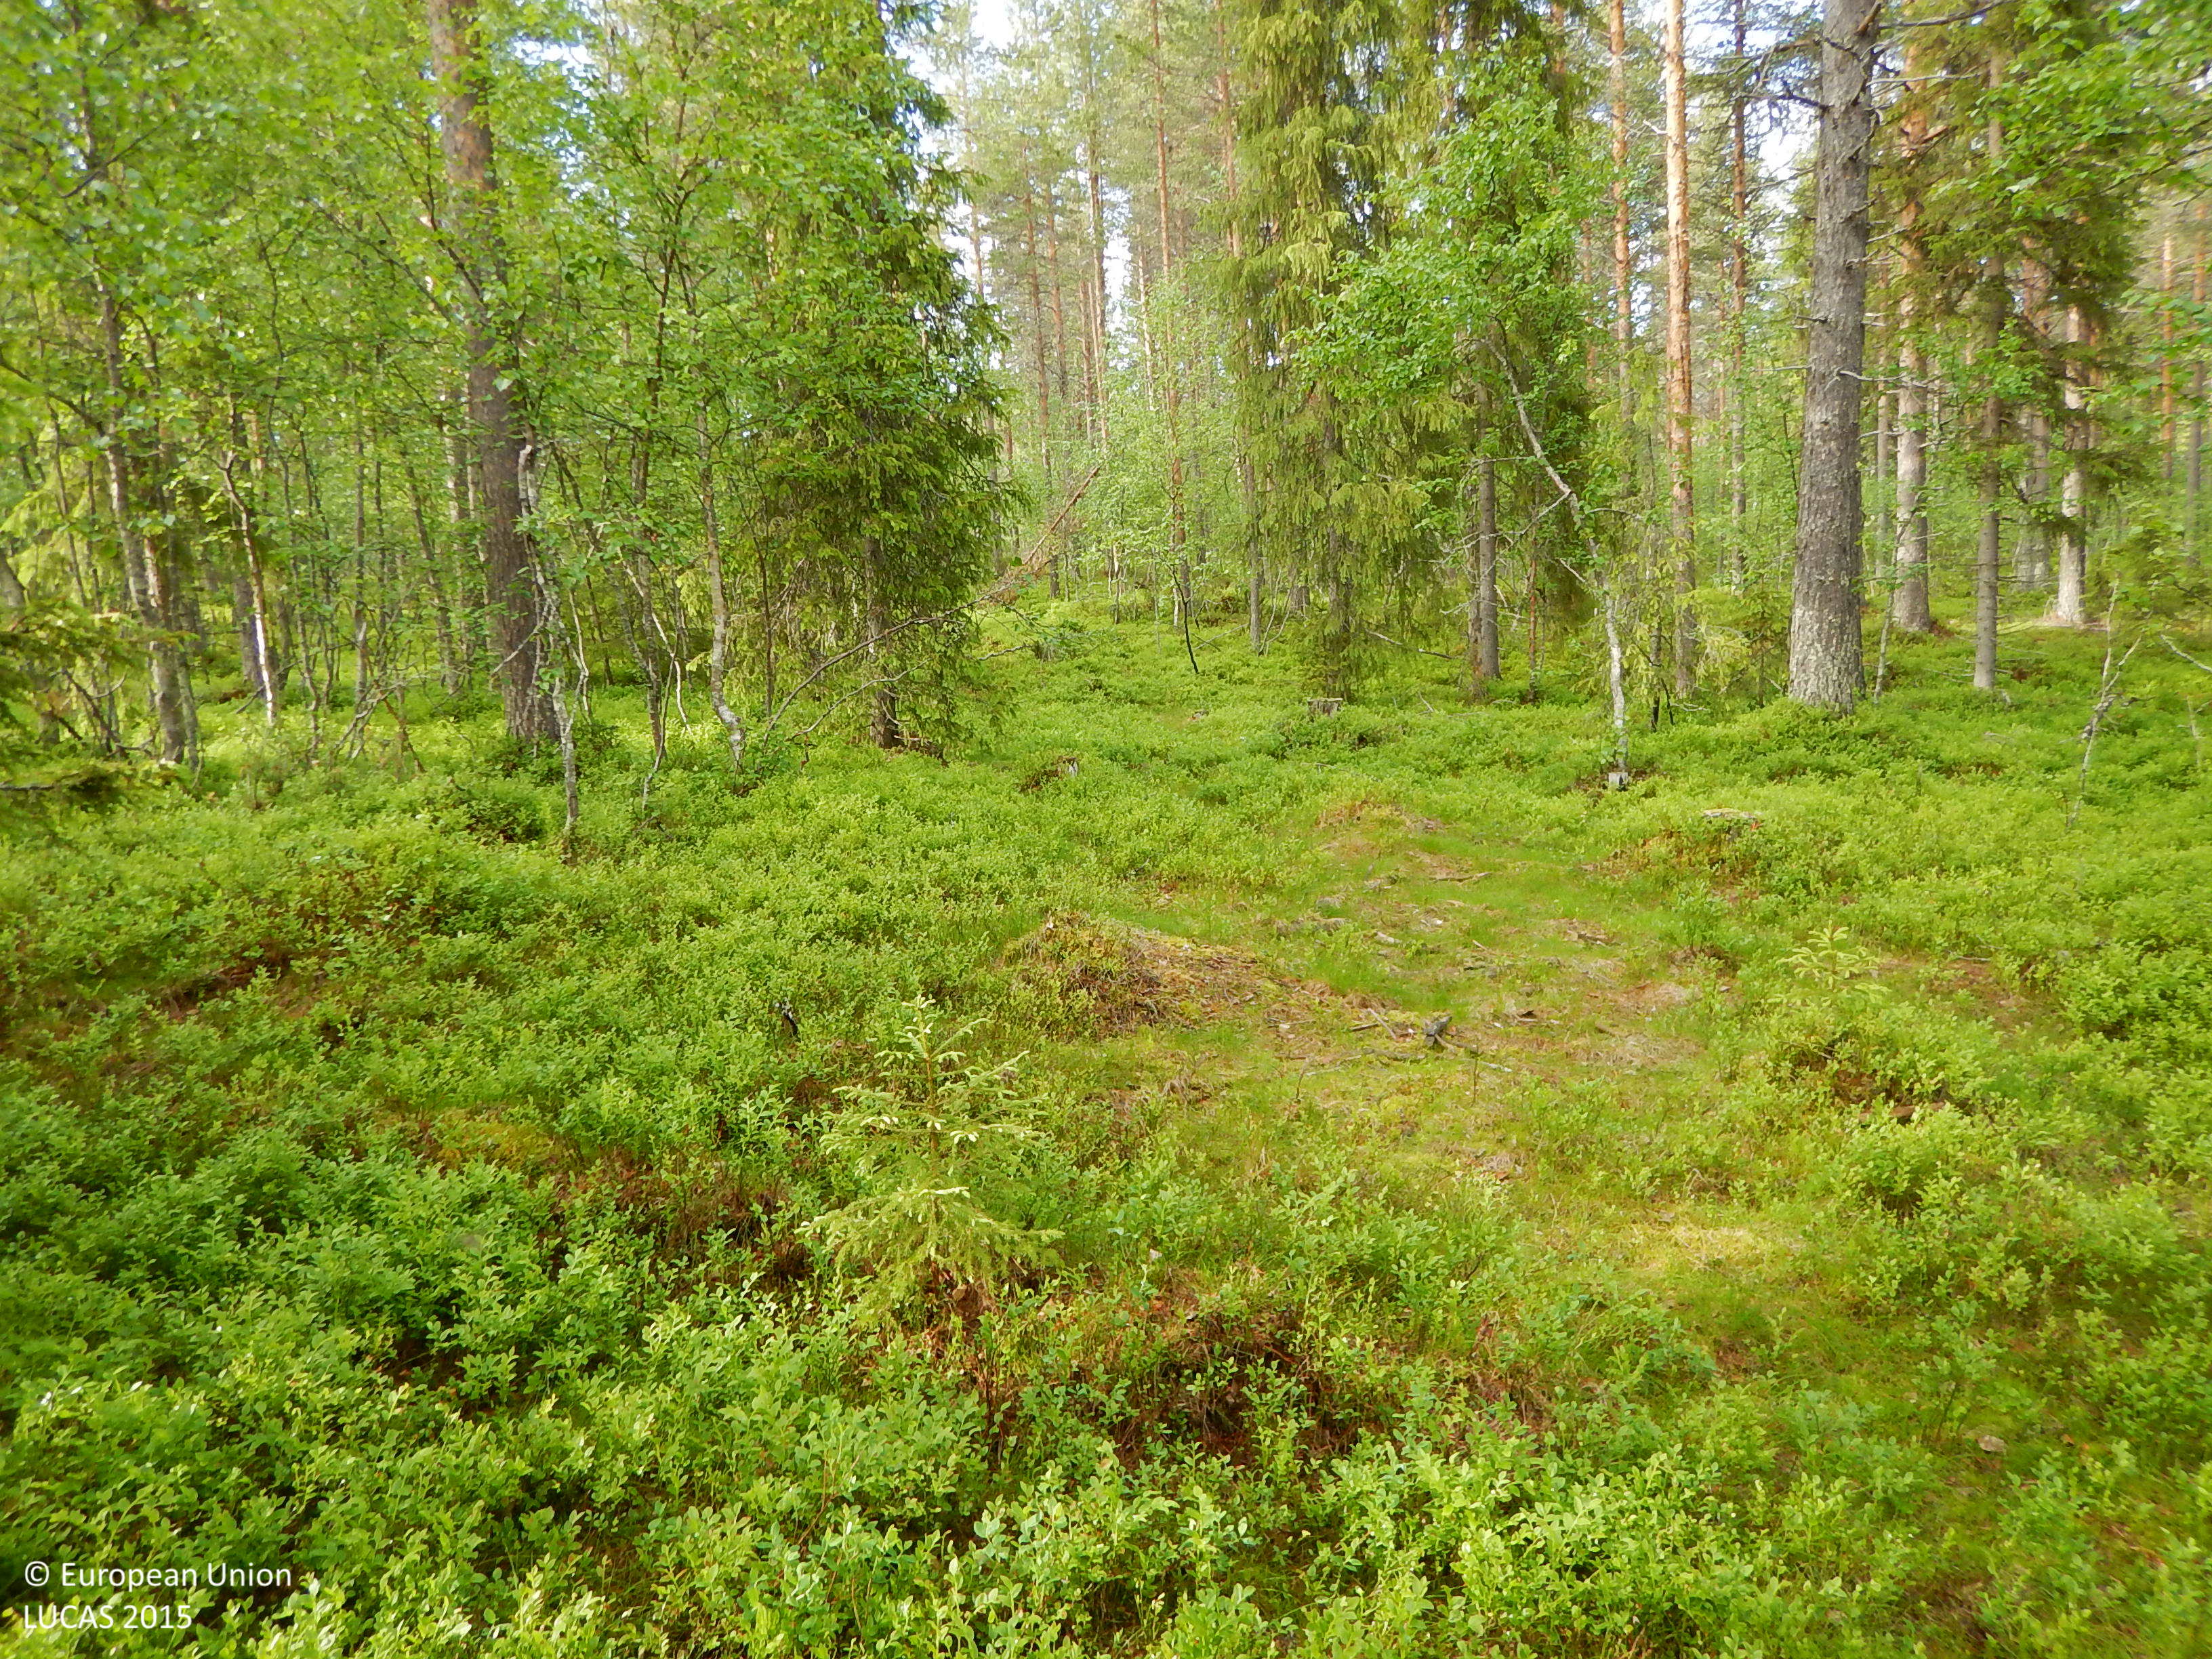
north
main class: Woodland
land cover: Other mixed woodland
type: boreal forest
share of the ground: 50 - 75 %
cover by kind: coniferous forest trees 45 %, shrubs 20 %, broadleaved forest trees 15 %, herbaceous plants 15 %, lichens and mosses 5 %
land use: Forestry
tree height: > 5 m
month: July
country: SE
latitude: 65.2935
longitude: 19.2479
